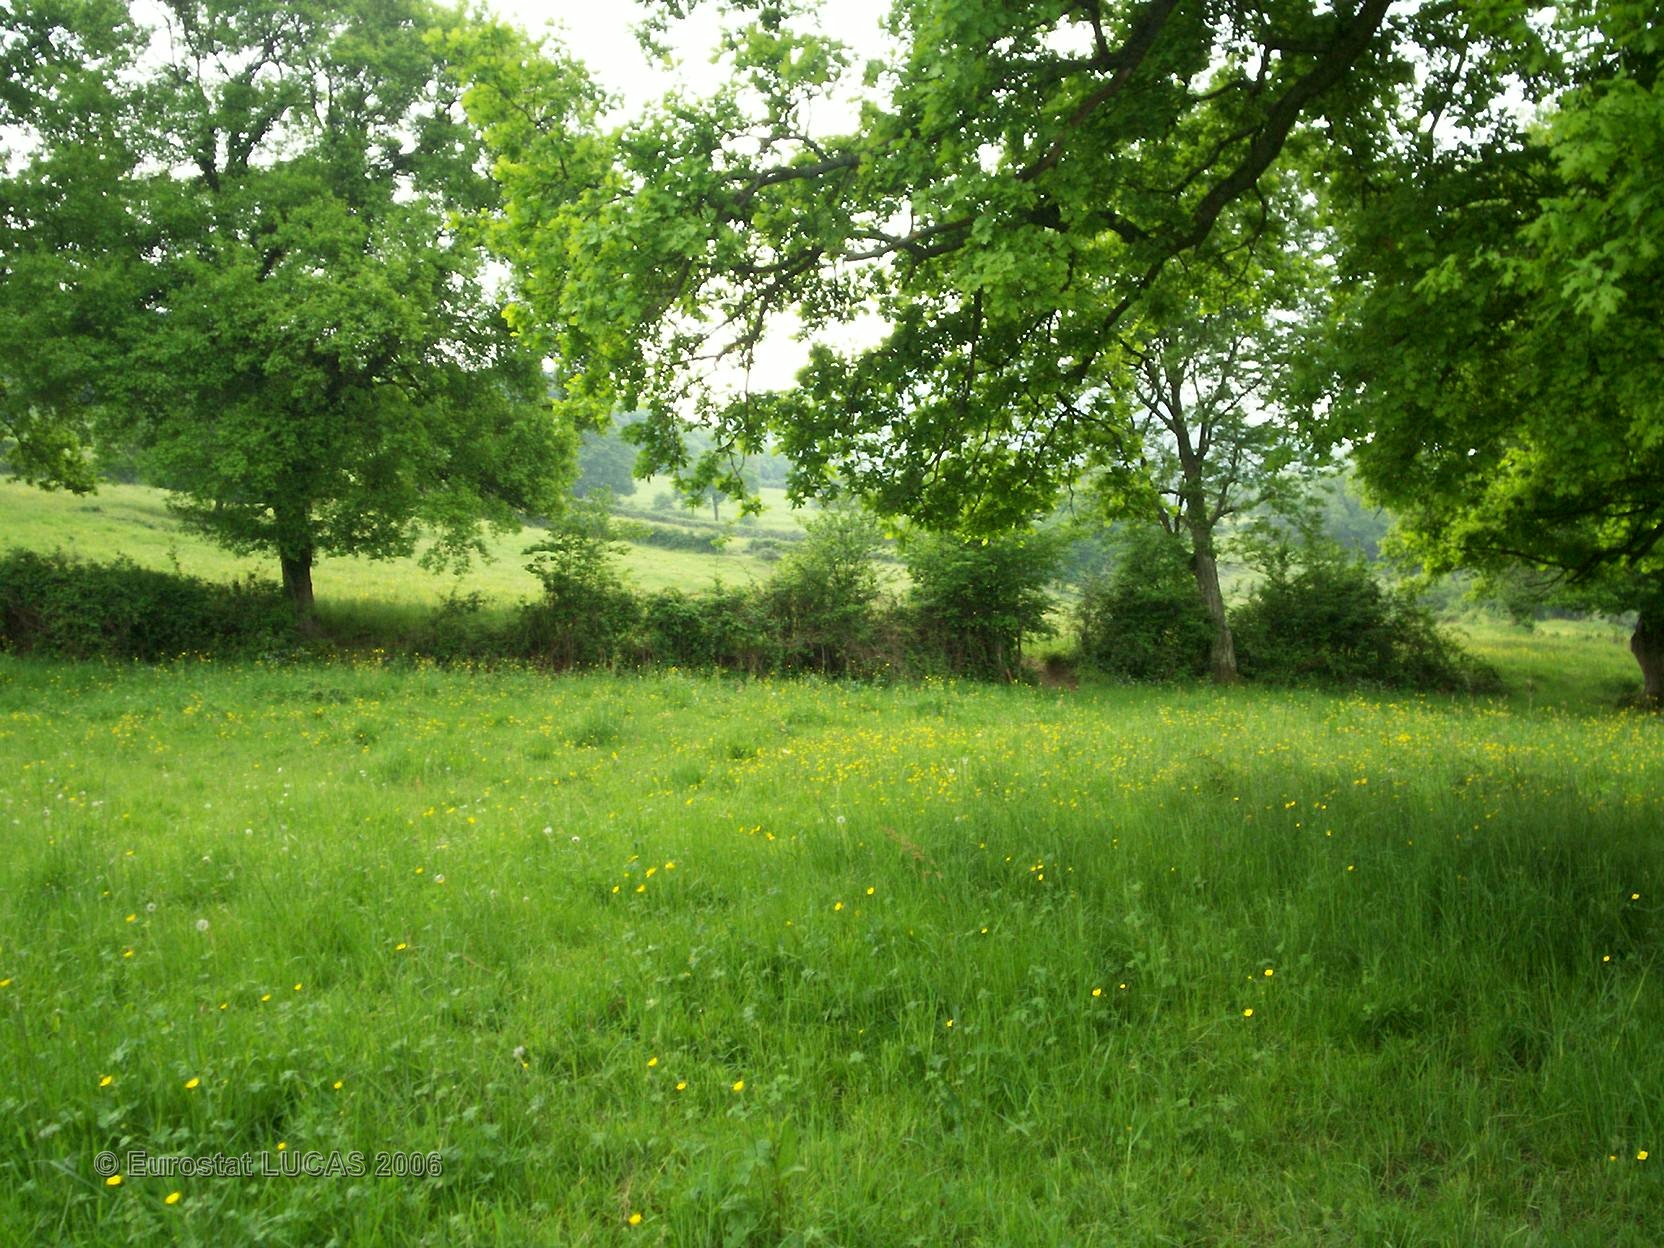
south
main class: Grassland
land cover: Grassland with sparse tree/shrub cover
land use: Agriculture (excluding fallow land and kitchen gardens)
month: May
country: FR
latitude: 46.5110
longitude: 4.7495
